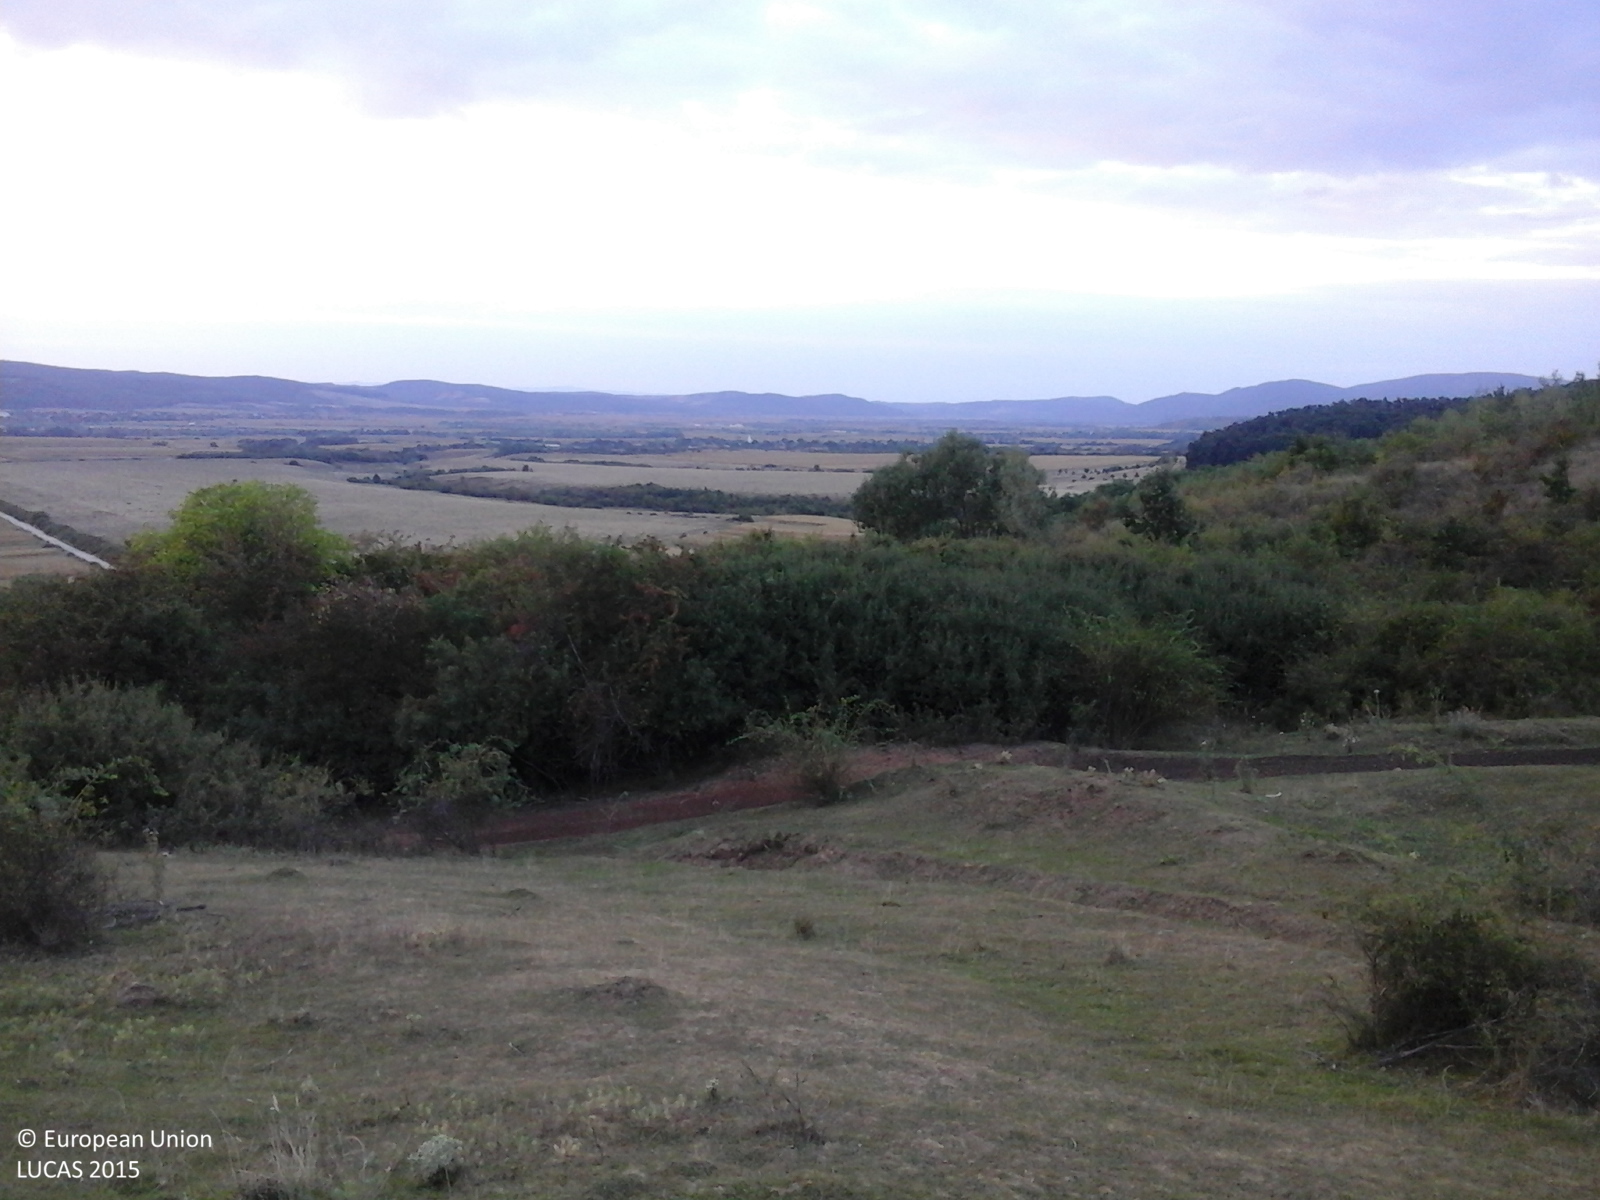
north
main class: Grassland
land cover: Grassland without tree/shrub cover
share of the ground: > 75 %
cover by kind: herbaceous plants 100 %
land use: Agriculture (excluding fallow land and kitchen gardens)
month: September
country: RO
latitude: 47.2852
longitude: 23.3038
